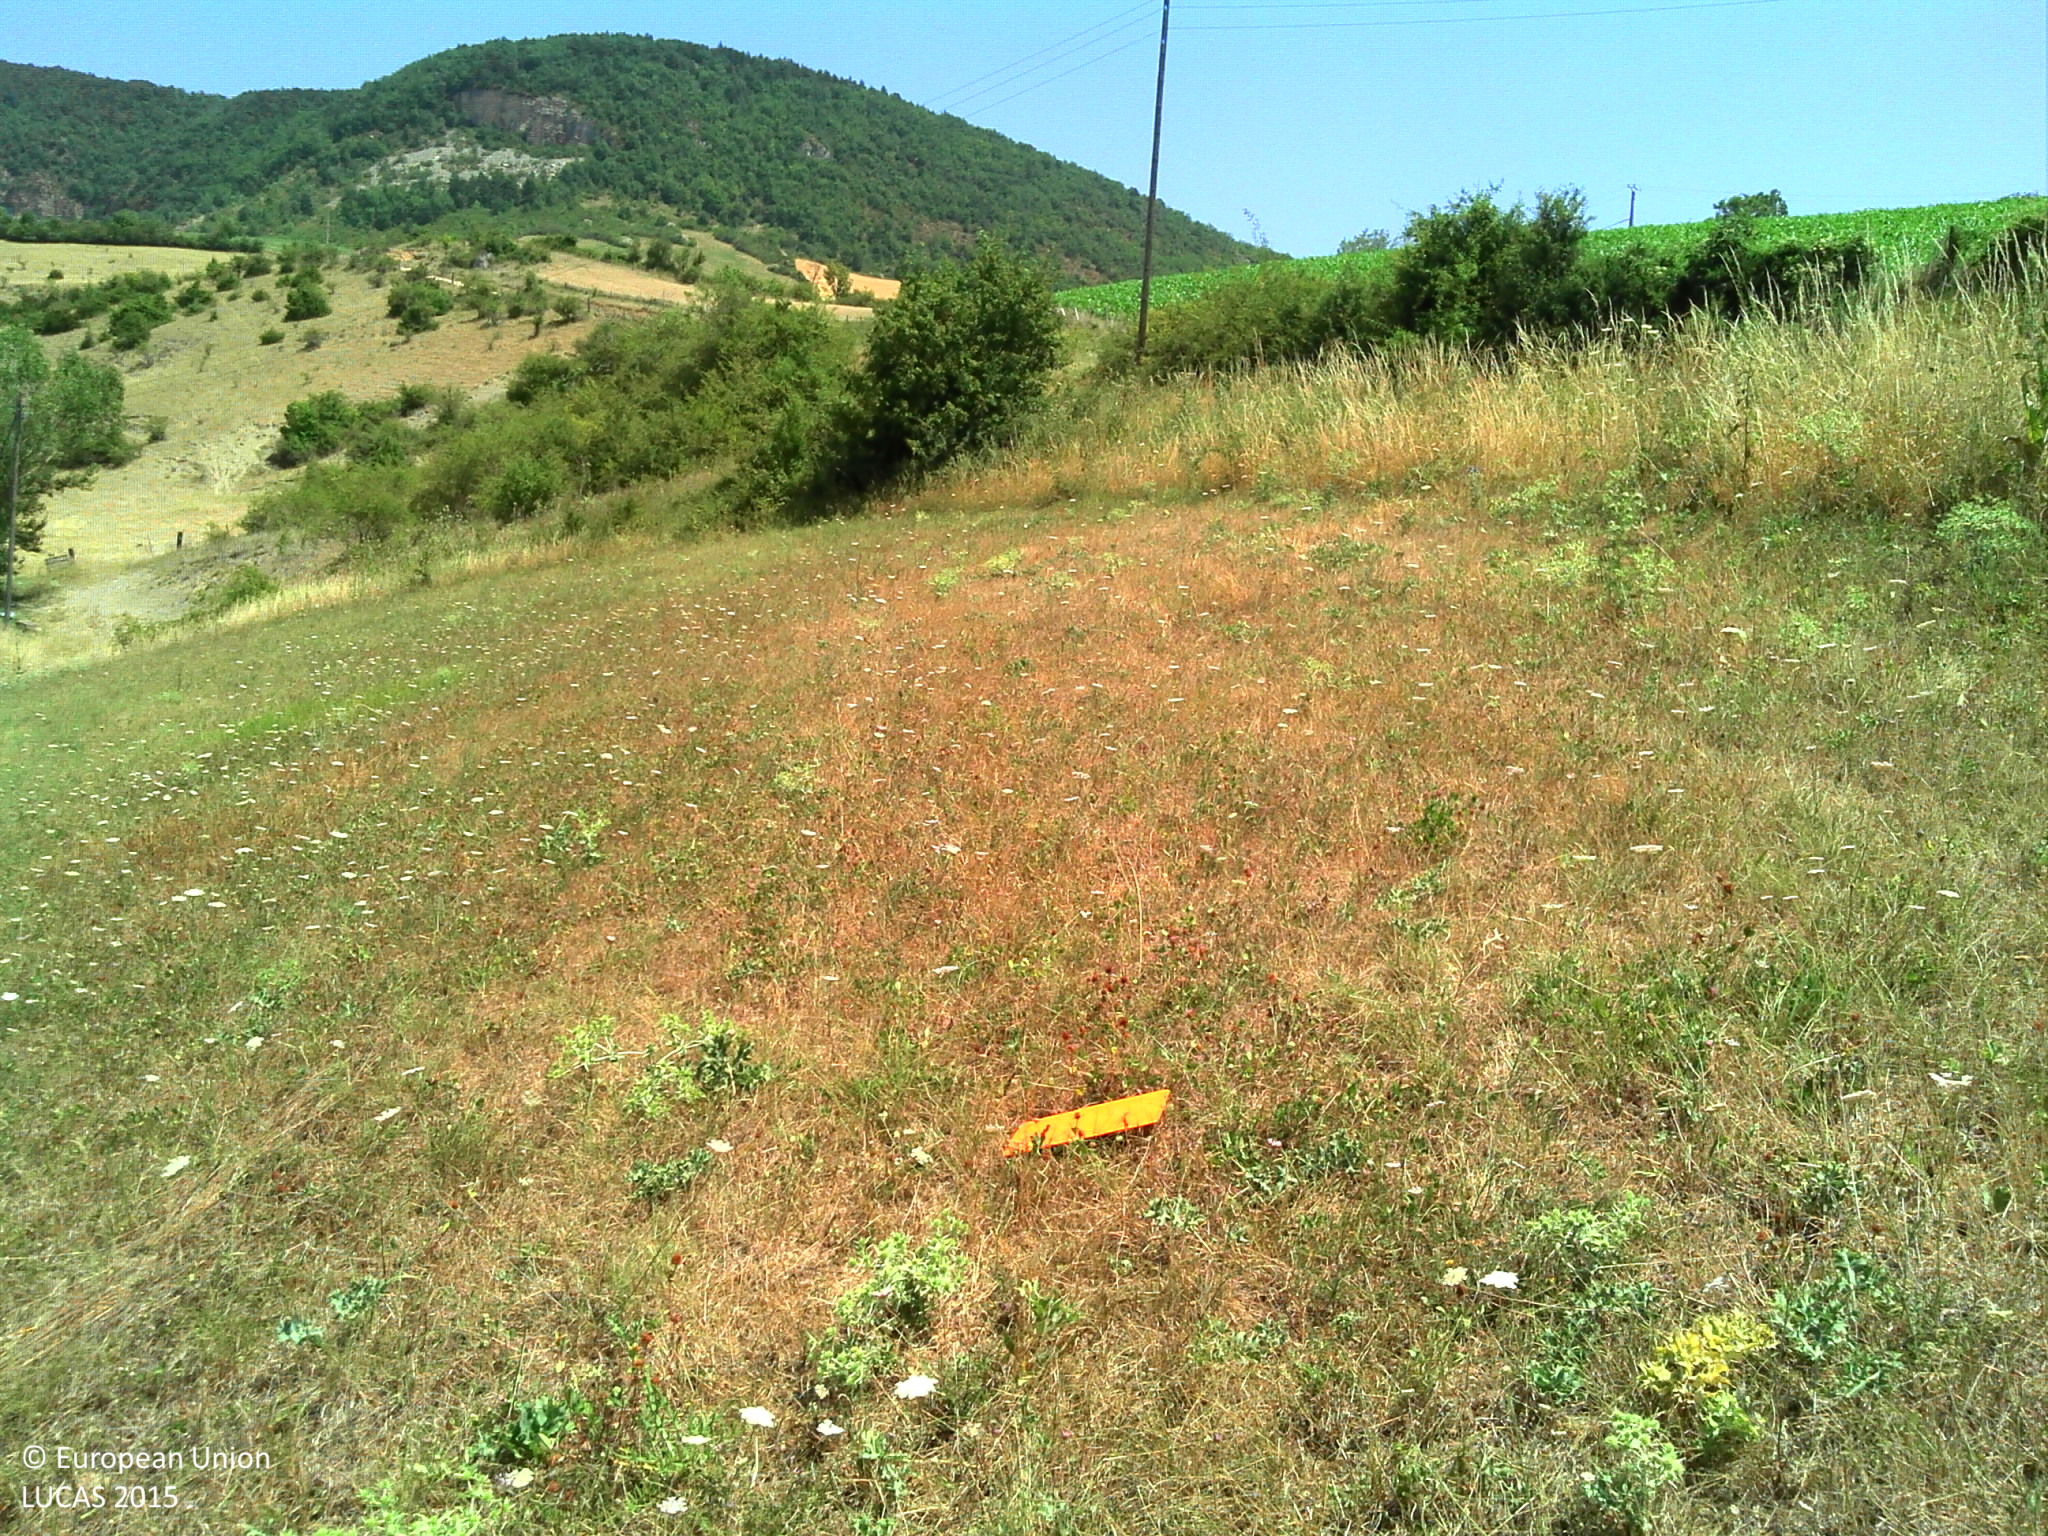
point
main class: Grassland
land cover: Grassland without tree/shrub cover
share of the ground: > 75 %
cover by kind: herbaceous plants 100 %
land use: Agriculture (excluding fallow land and kitchen gardens)
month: July
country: FR
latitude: 44.1743
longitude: 3.0889
